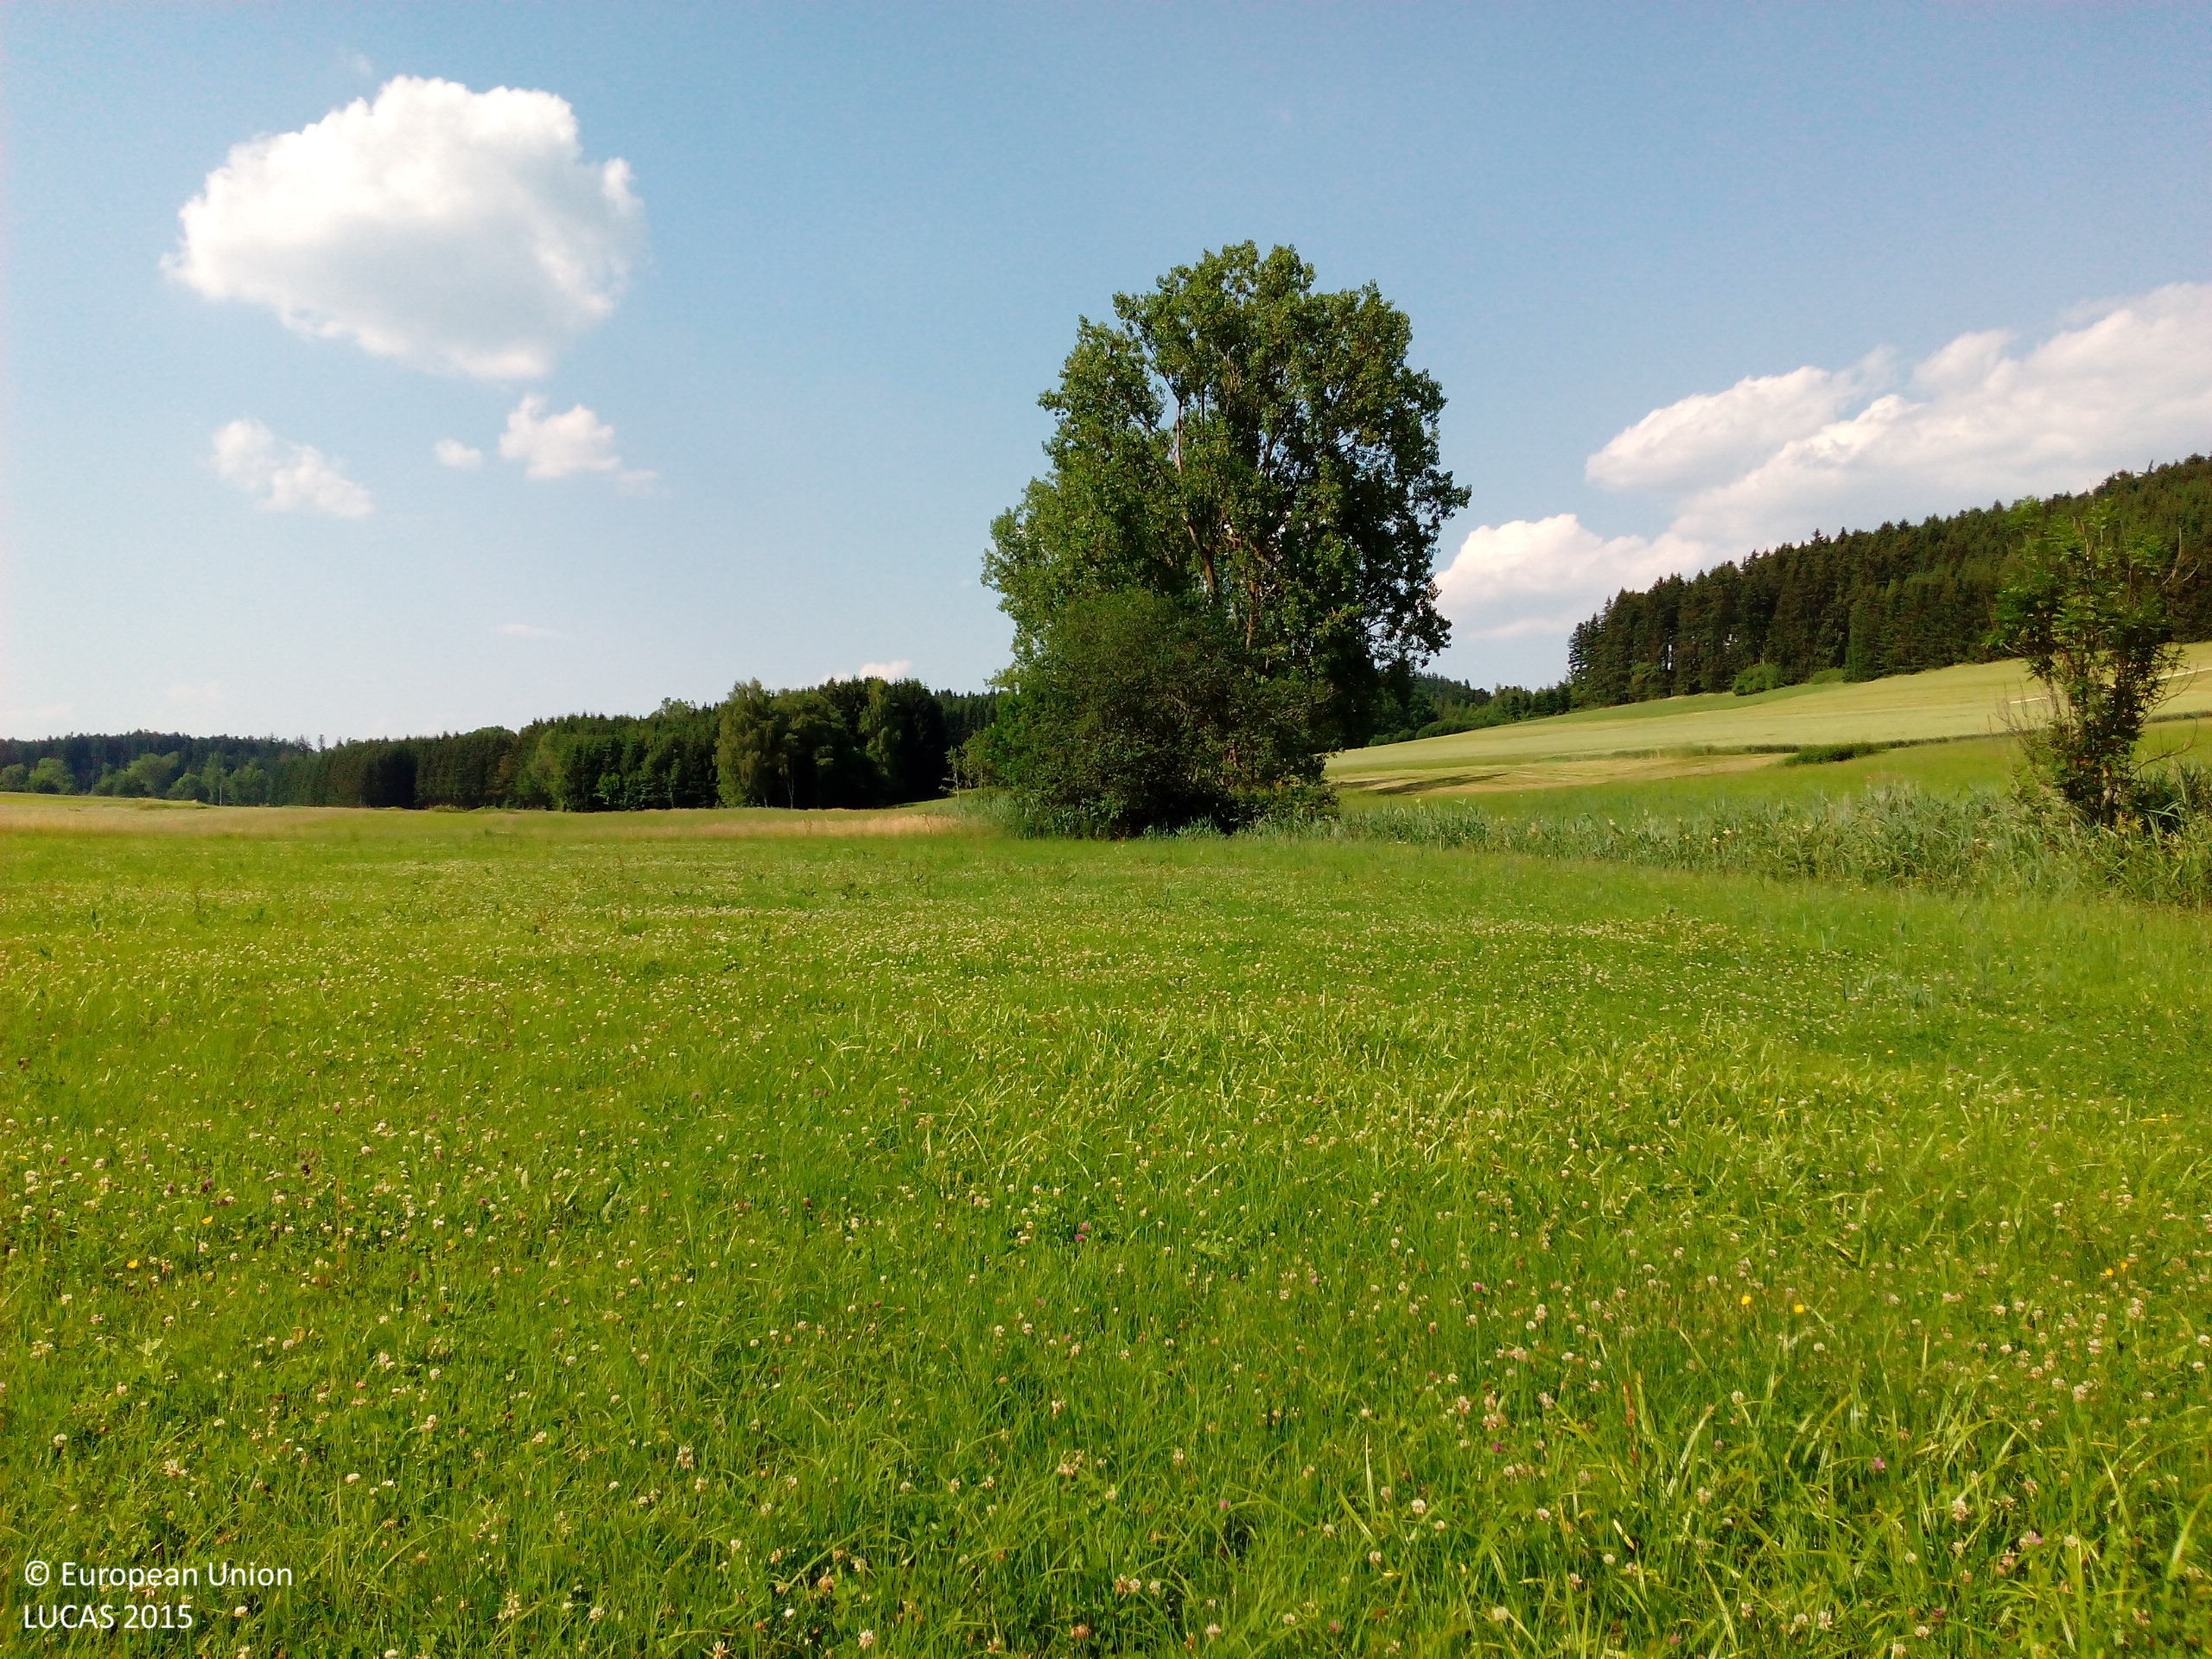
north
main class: Grassland
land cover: Grassland without tree/shrub cover
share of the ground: > 75 %
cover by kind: herbaceous plants 100 %
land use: Agriculture (excluding fallow land and kitchen gardens)
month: July
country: DE
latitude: 48.0539
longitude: 8.6994
